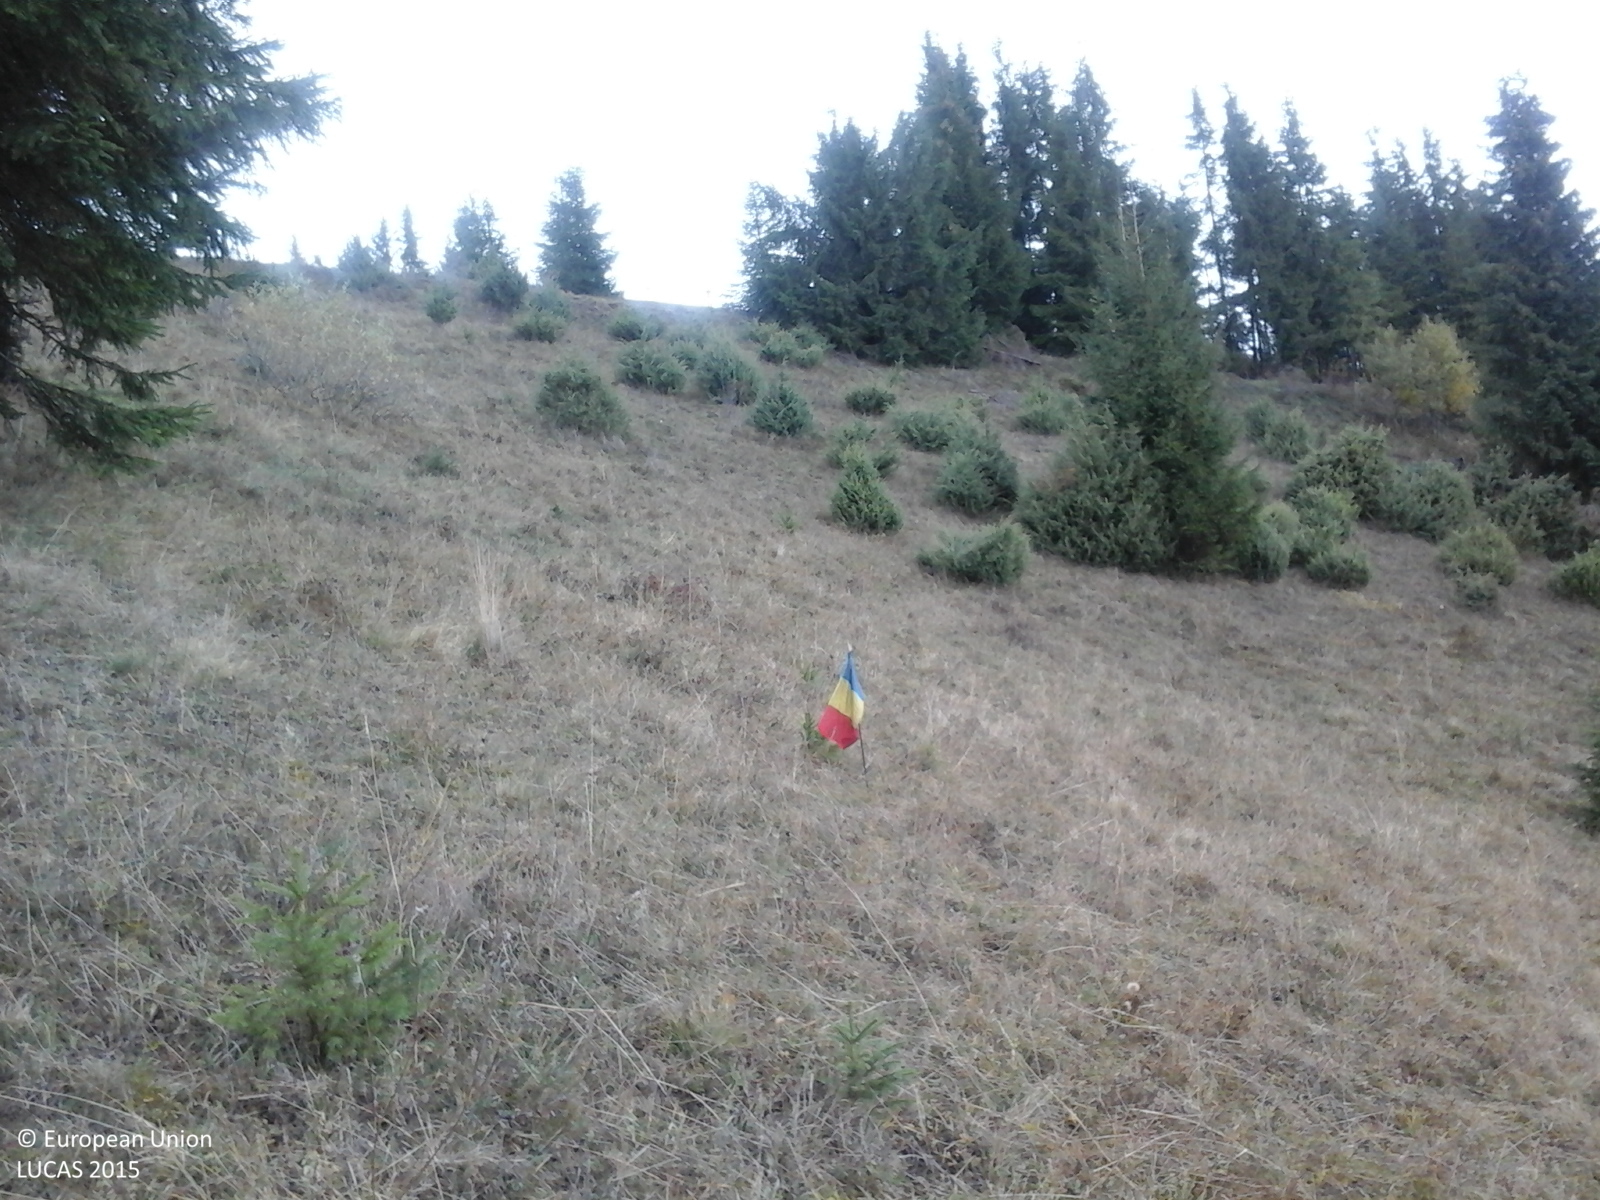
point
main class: Grassland
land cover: Grassland with sparse tree/shrub cover
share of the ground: > 75 %
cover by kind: herbaceous plants 95 %, coniferous forest trees 5 %
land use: Agriculture (excluding fallow land and kitchen gardens)
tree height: > 5 m
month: October
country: RO
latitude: 46.8798
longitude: 25.5036
